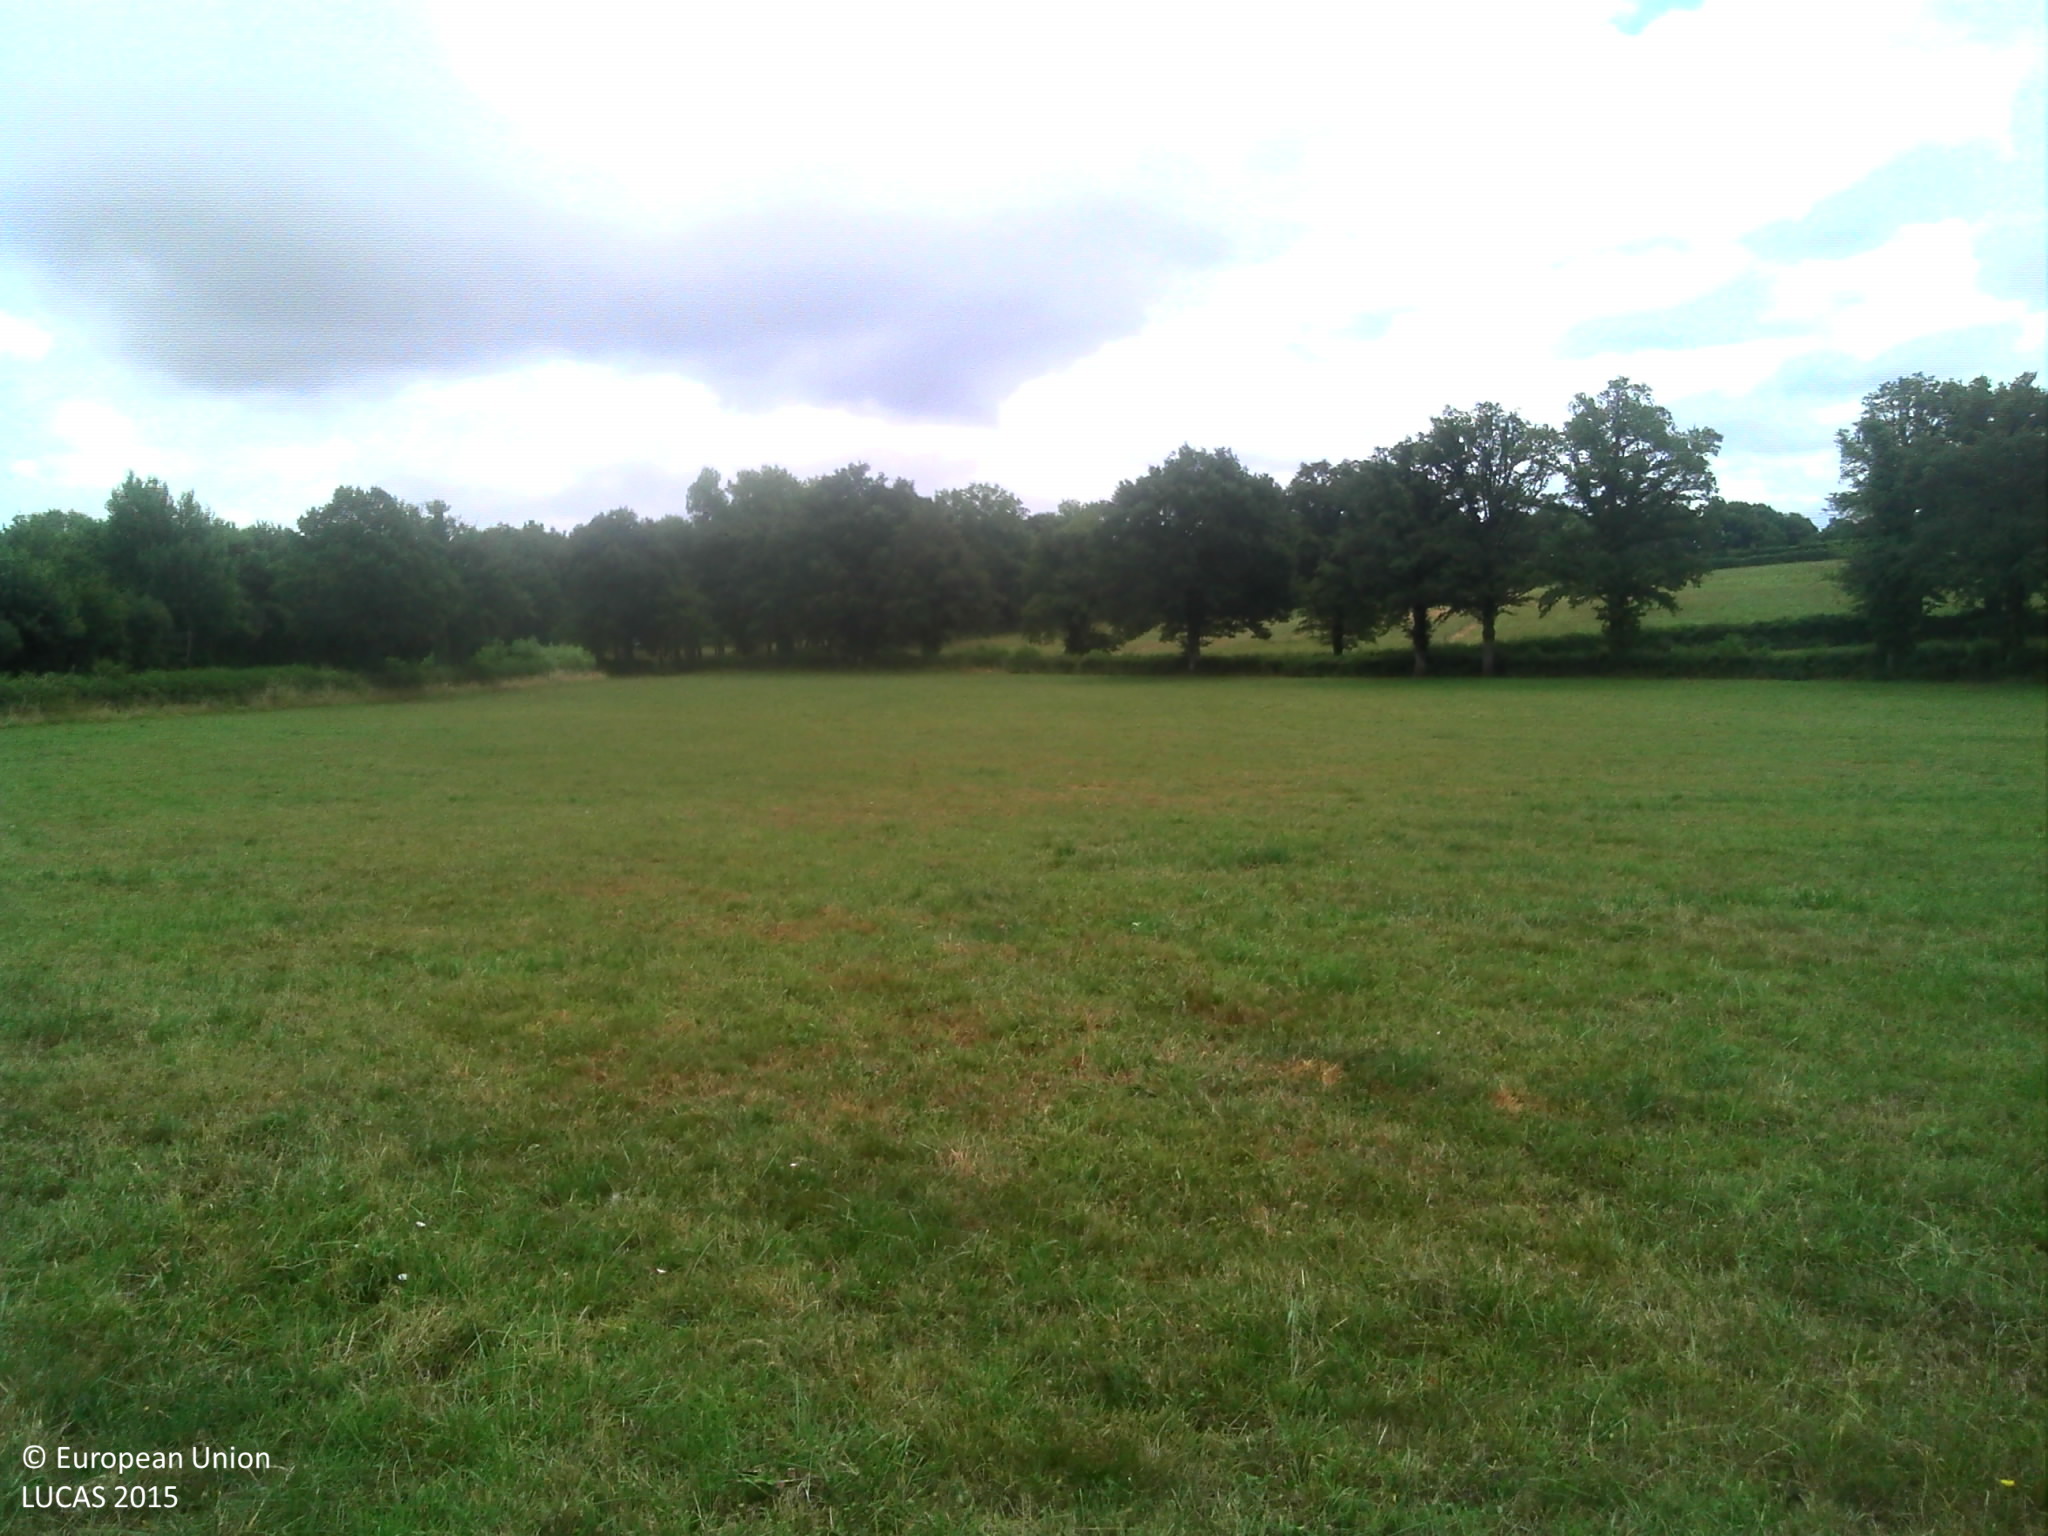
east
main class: Grassland
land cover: Grassland without tree/shrub cover
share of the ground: > 75 %
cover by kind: herbaceous plants 100 %
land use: Agriculture (excluding fallow land and kitchen gardens)
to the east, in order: Grassland without tree/shrub cover; Artificial constructions; Managed hedges; Fences; Grassland without tree/shrub cover; Managed hedges; Lines of trees; Fences; Grassland without tree/shrub cover
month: July
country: FR
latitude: 46.3766
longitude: 1.5267
